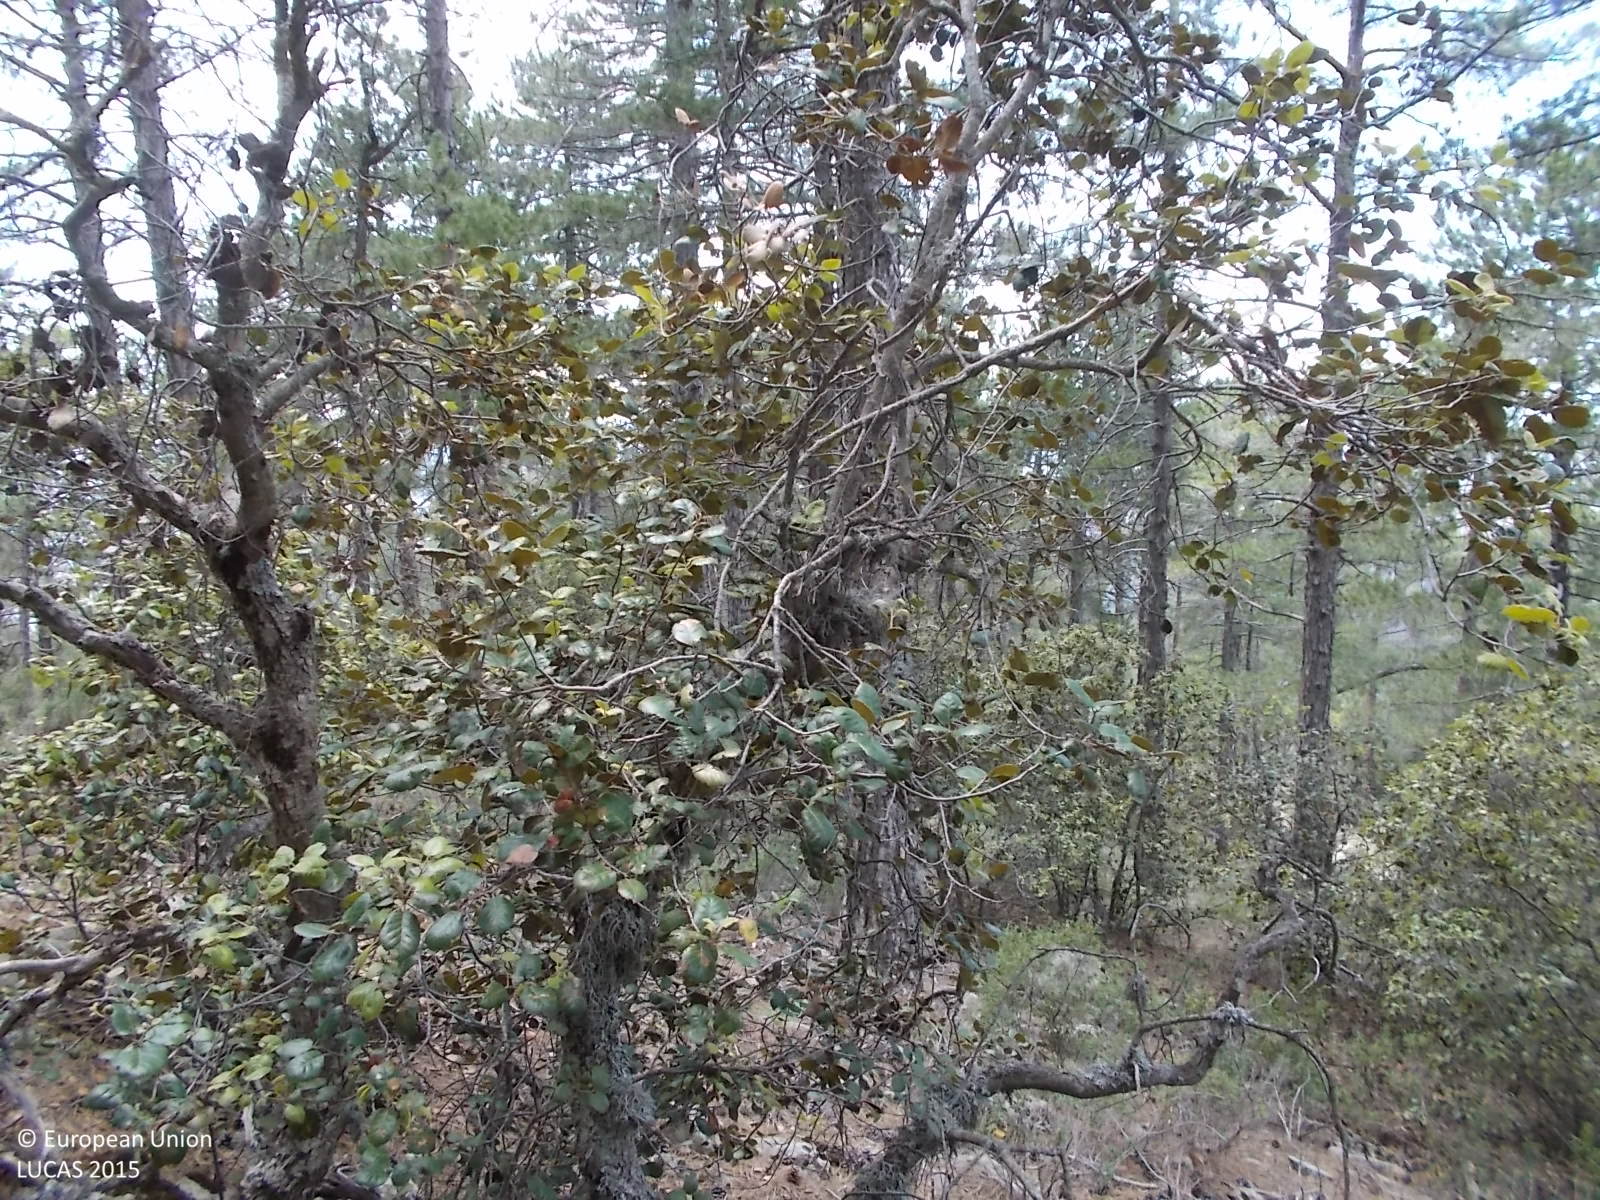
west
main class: Woodland
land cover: Pine dominated mixed woodland
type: coniferous forest of the mediterranean region
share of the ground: > 75 %
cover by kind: coniferous forest trees 70 %, broadleaved forest trees 25 %, shrubs 5 %
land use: Forestry
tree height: > 5 m
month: June
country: CY
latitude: 34.9292
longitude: 32.8372
